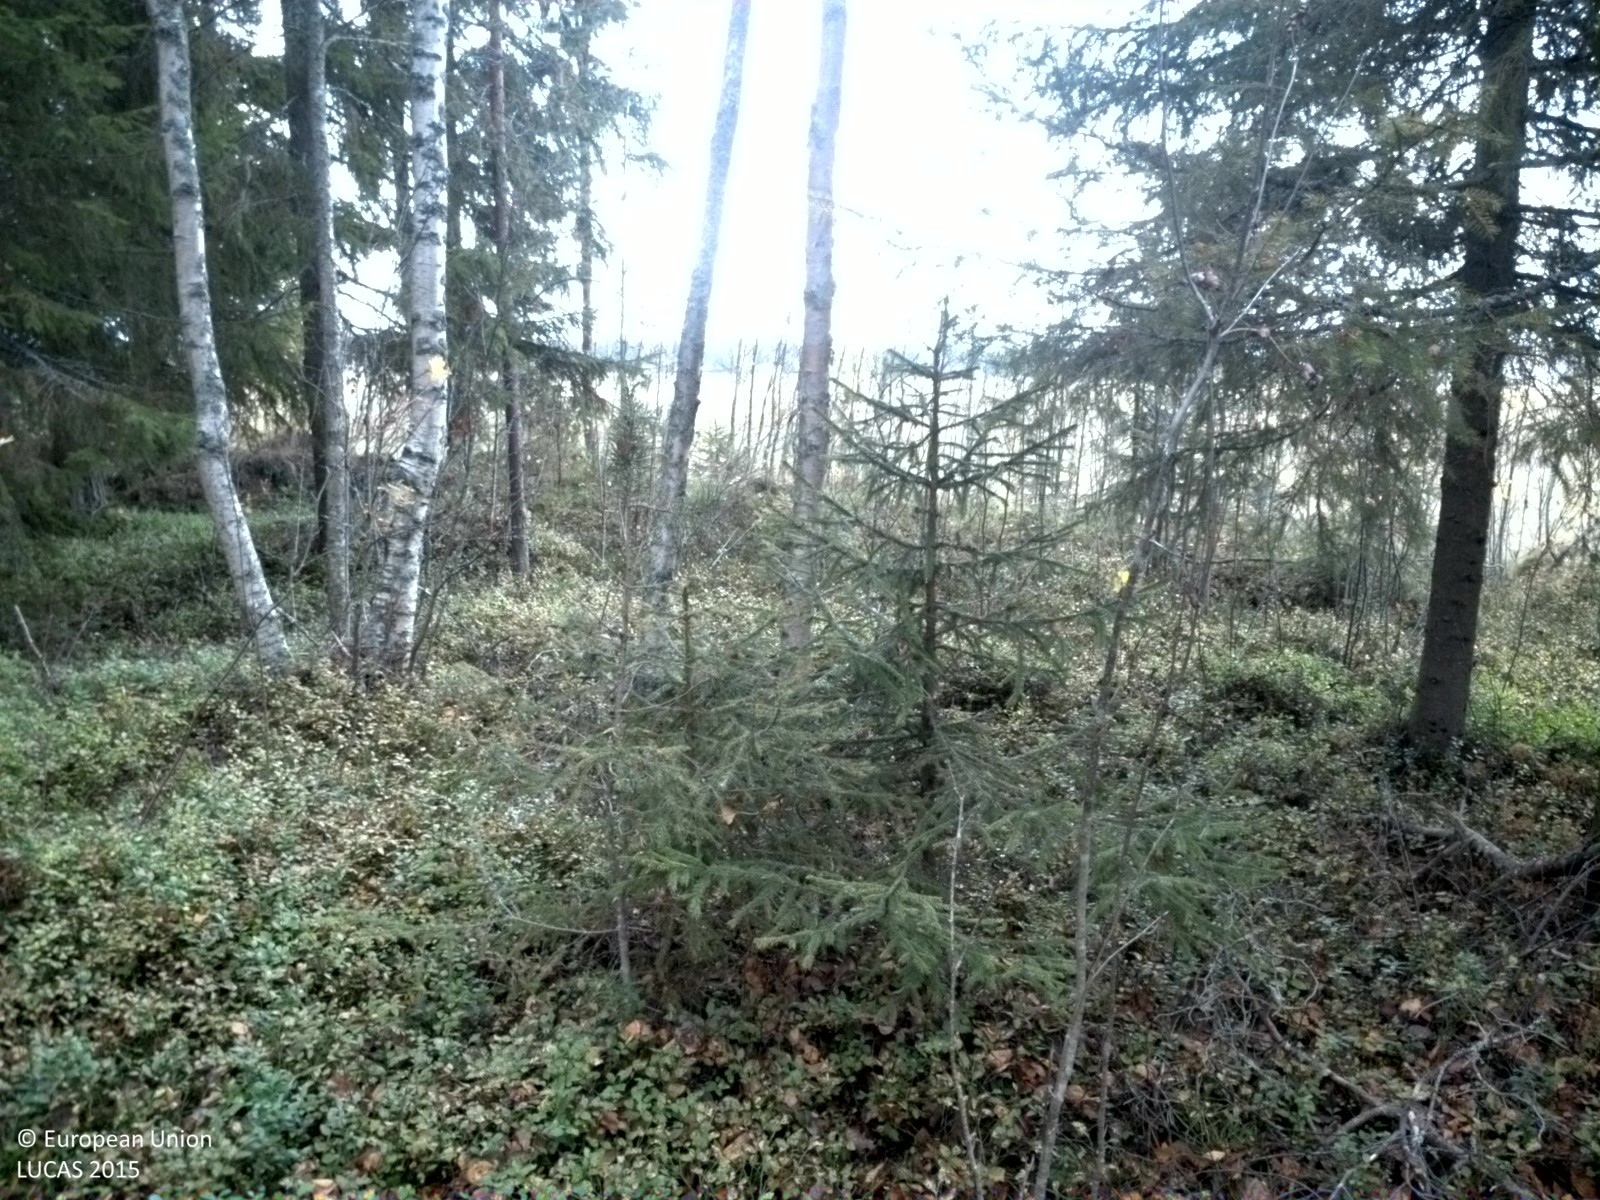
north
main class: Woodland
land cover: Spruce dominated mixed woodland
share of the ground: 25 - 50 %
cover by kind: shrubs 50 %, broadleaved forest trees 30 %, coniferous forest trees 20 %
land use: Forestry
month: October
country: SE
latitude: 65.6340
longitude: 21.9022
